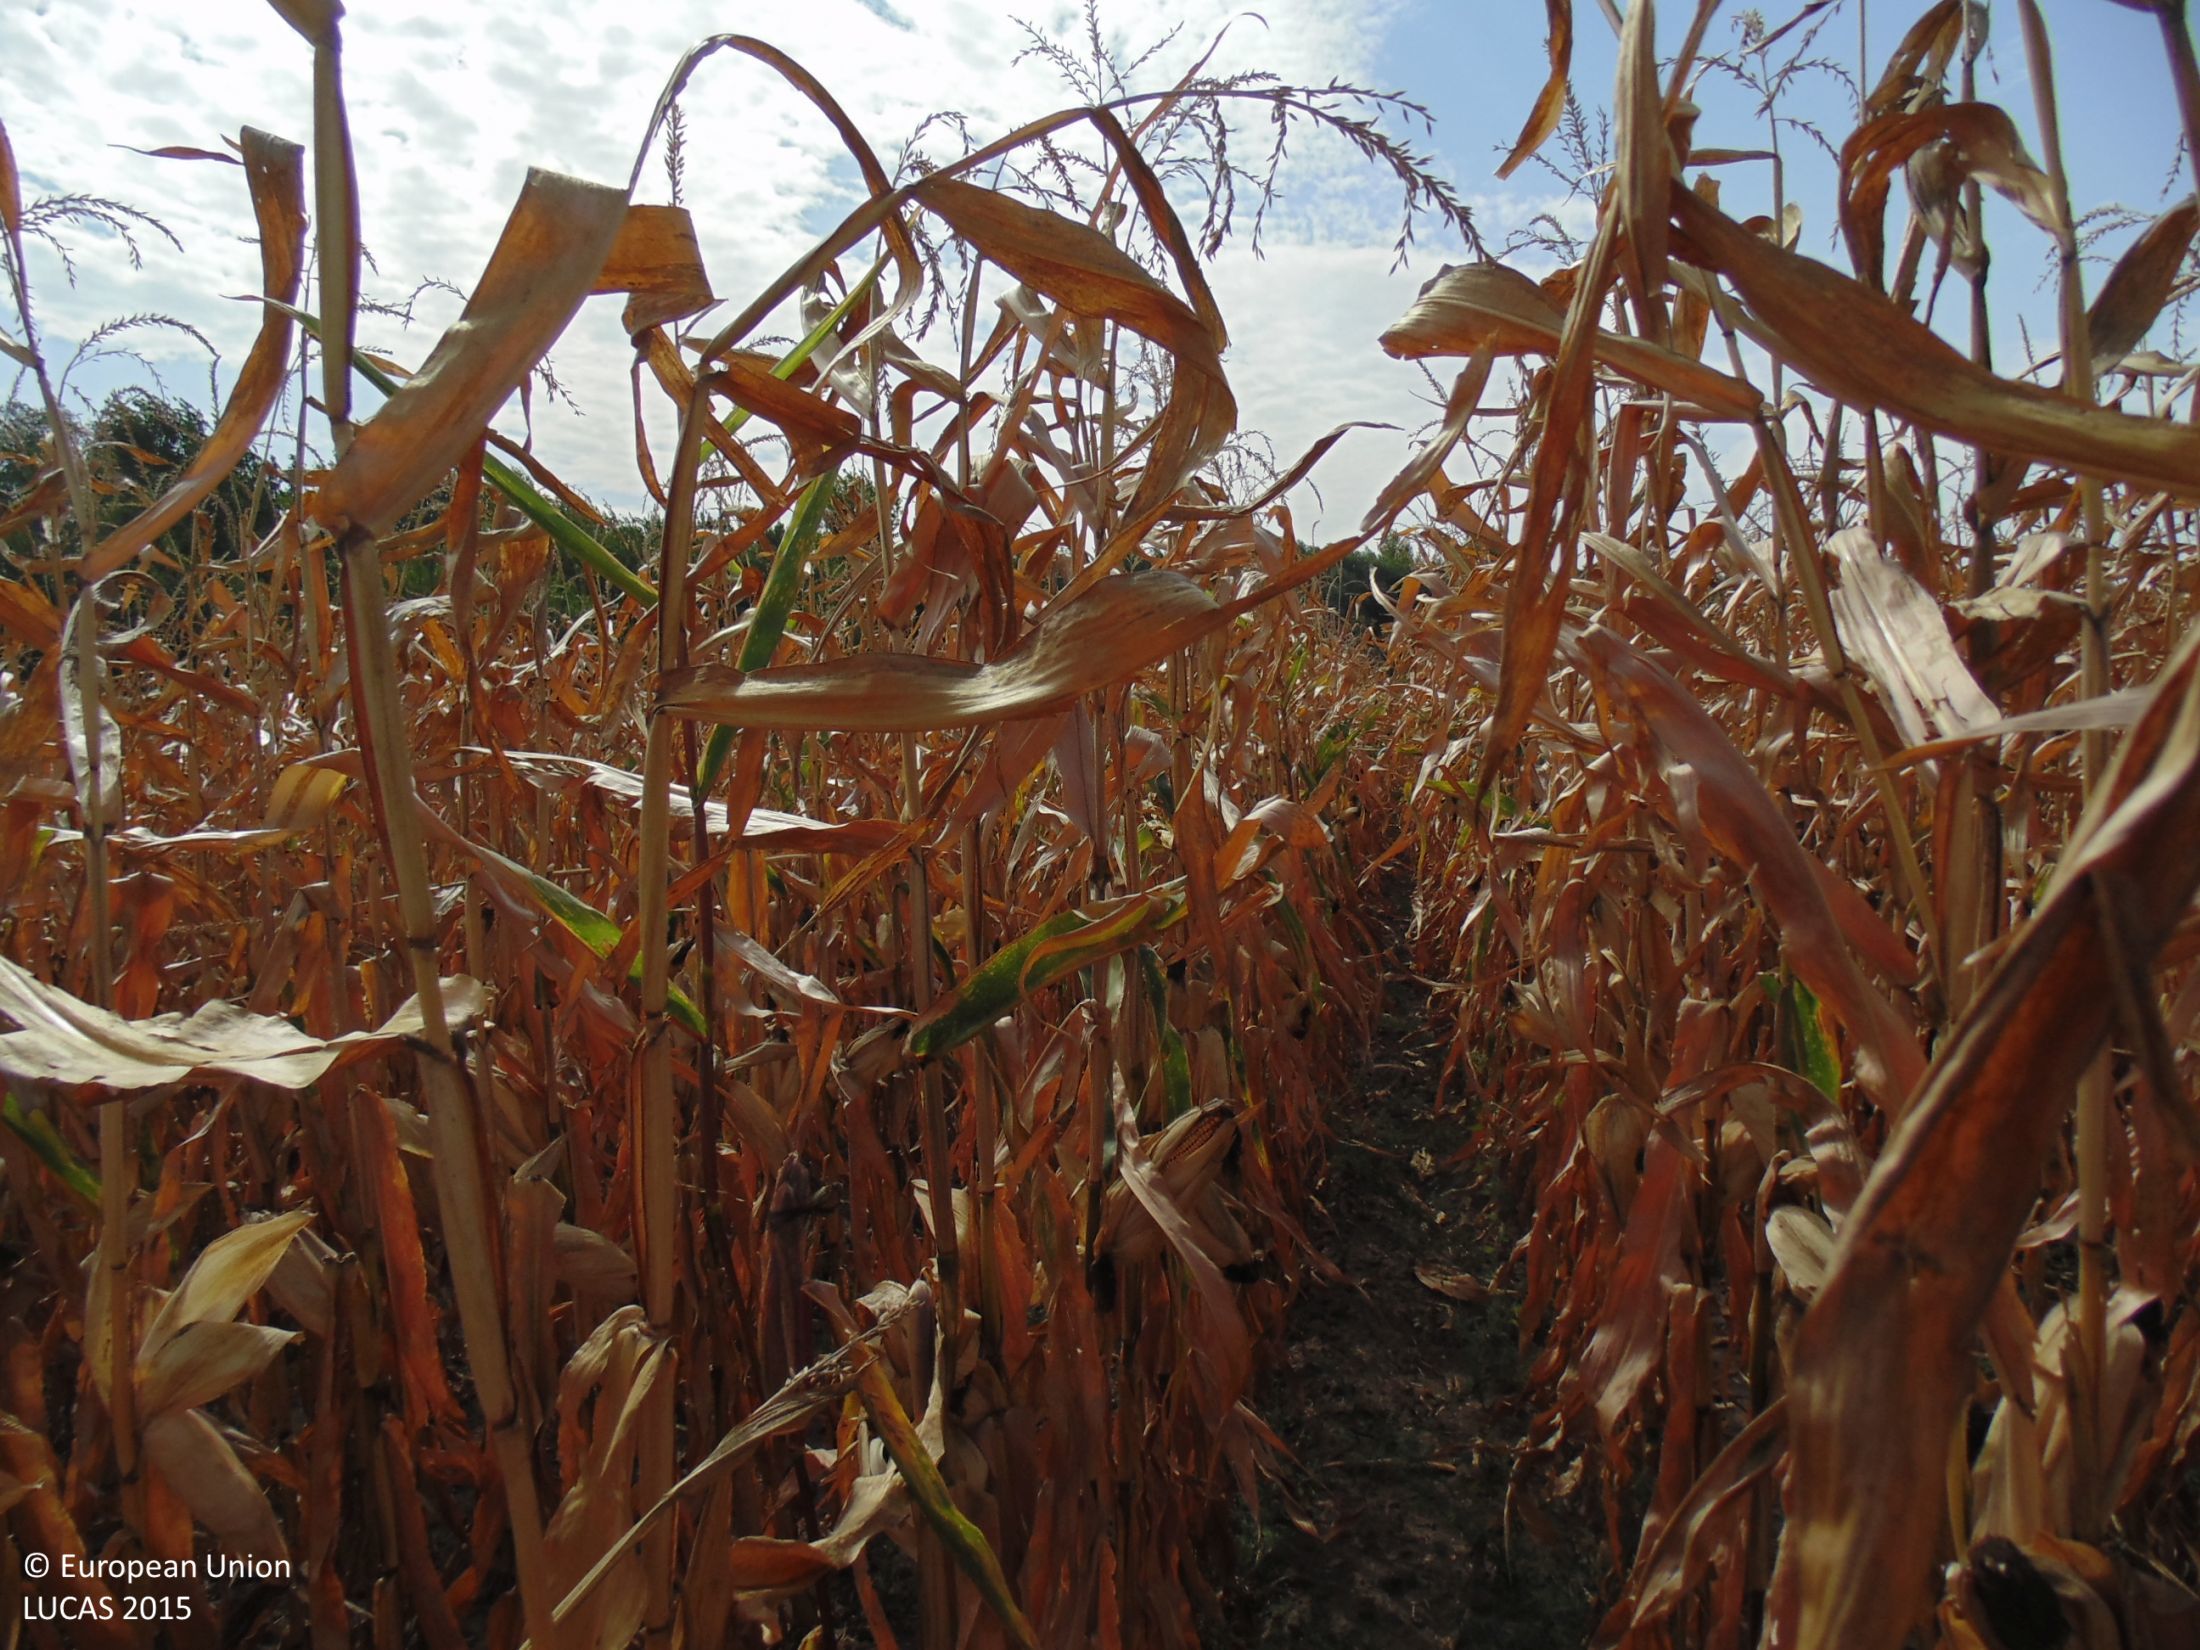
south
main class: Cropland
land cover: Maize
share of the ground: > 75 %
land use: Agriculture (excluding fallow land and kitchen gardens)
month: September
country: BG
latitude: 44.0402
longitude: 27.2137
